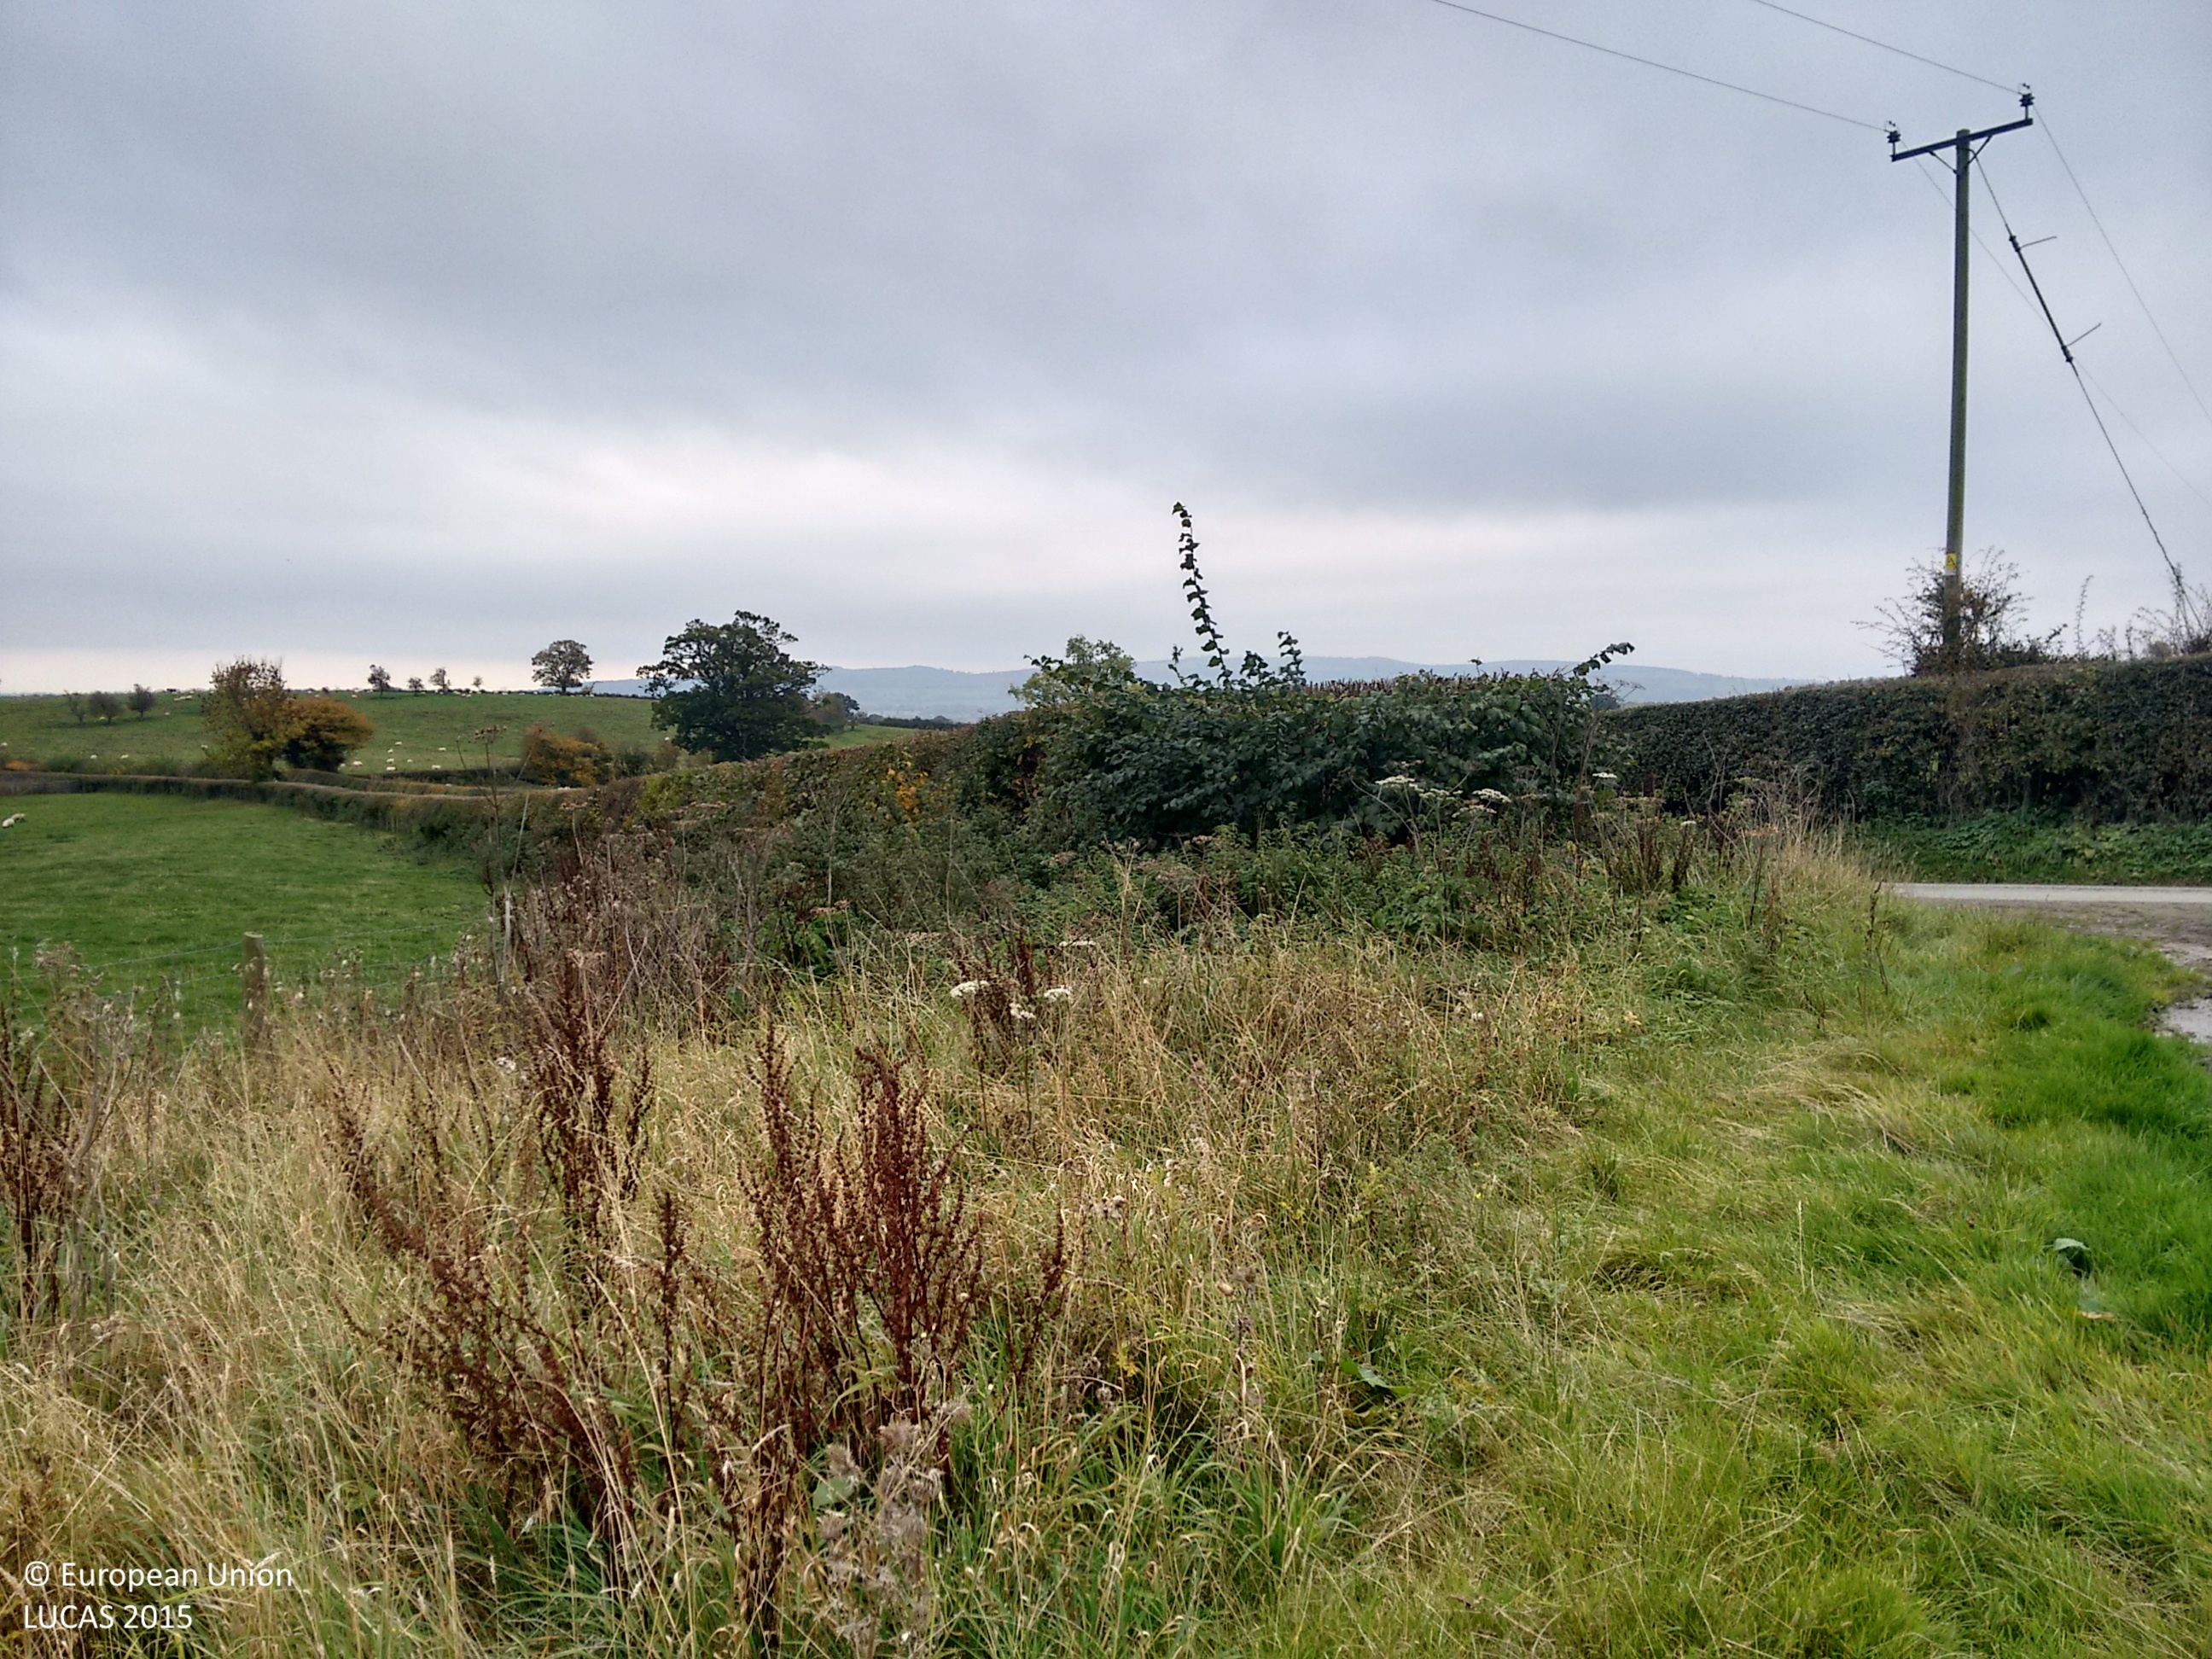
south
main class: Grassland
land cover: Grassland without tree/shrub cover
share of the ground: > 75 %
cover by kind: herbaceous plants 100 %
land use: Agriculture (excluding fallow land and kitchen gardens)
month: October
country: GB
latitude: 52.4284
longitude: -2.7928
